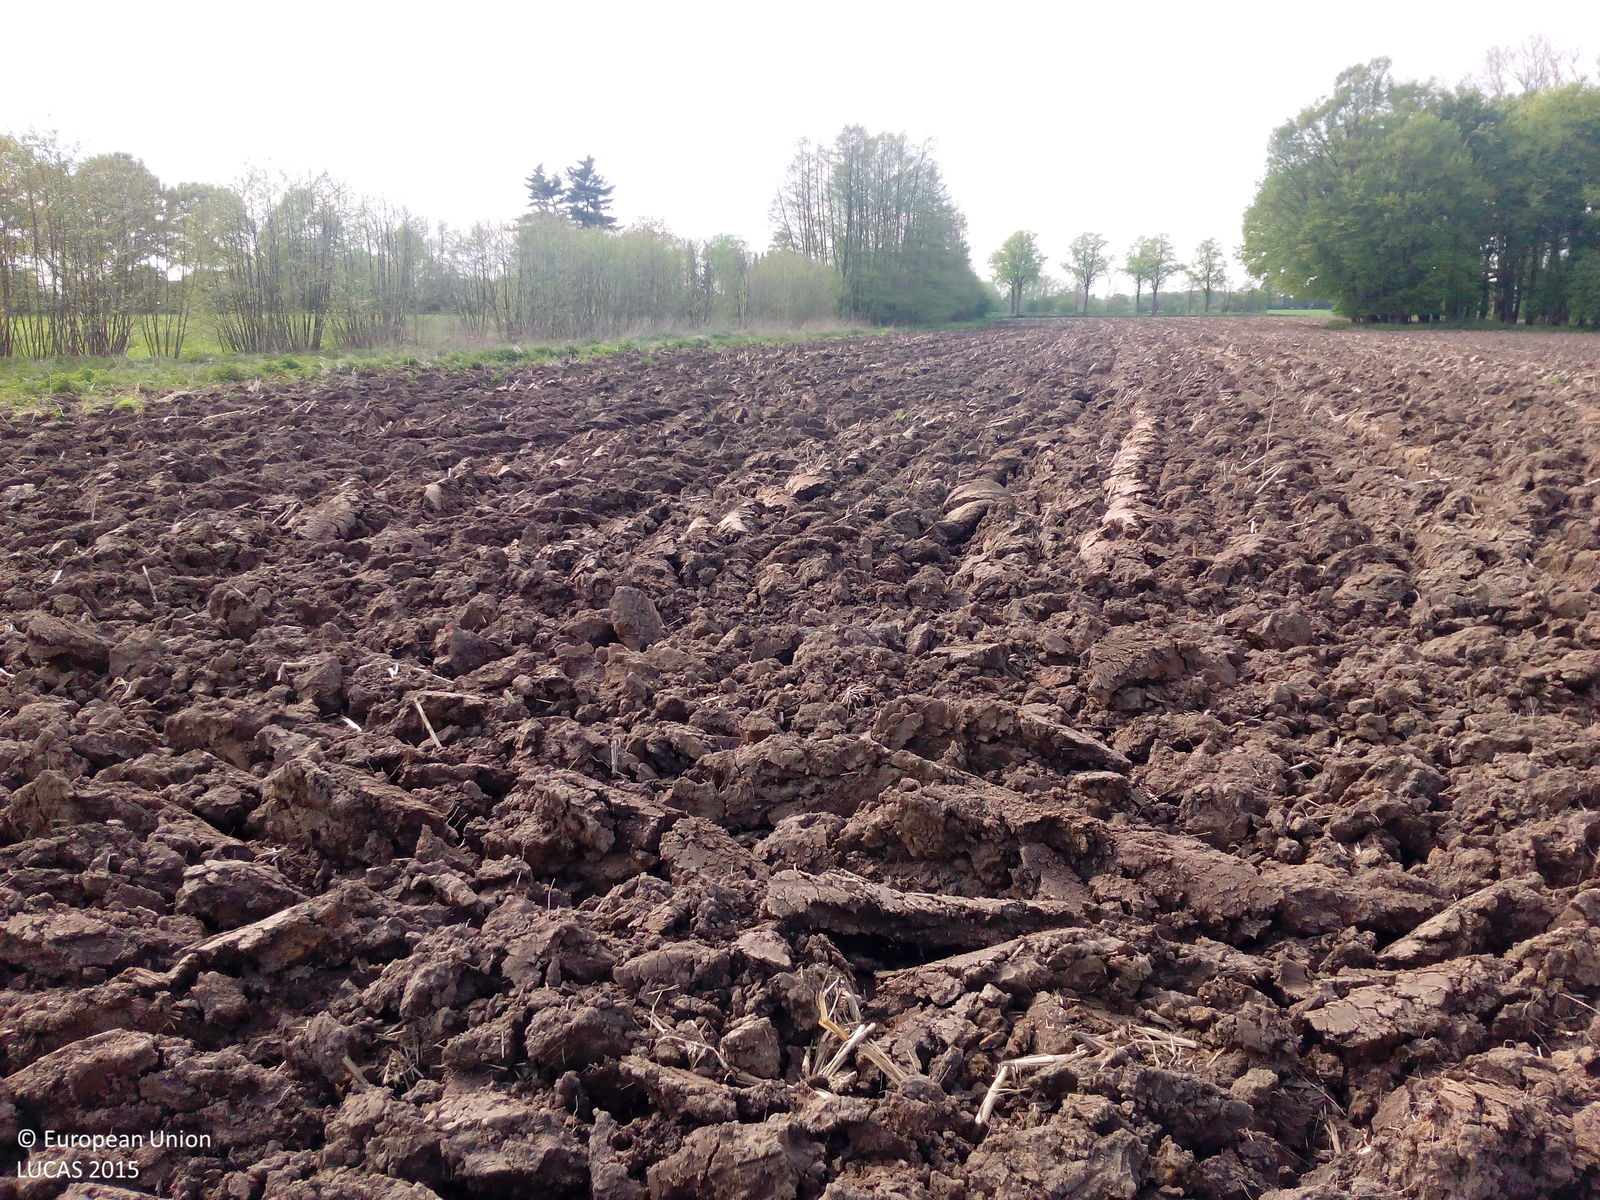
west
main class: Cropland
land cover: Maize
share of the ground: < 10 %
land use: Agriculture (excluding fallow land and kitchen gardens)
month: May
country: DE
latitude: 51.8276
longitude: 7.4030
